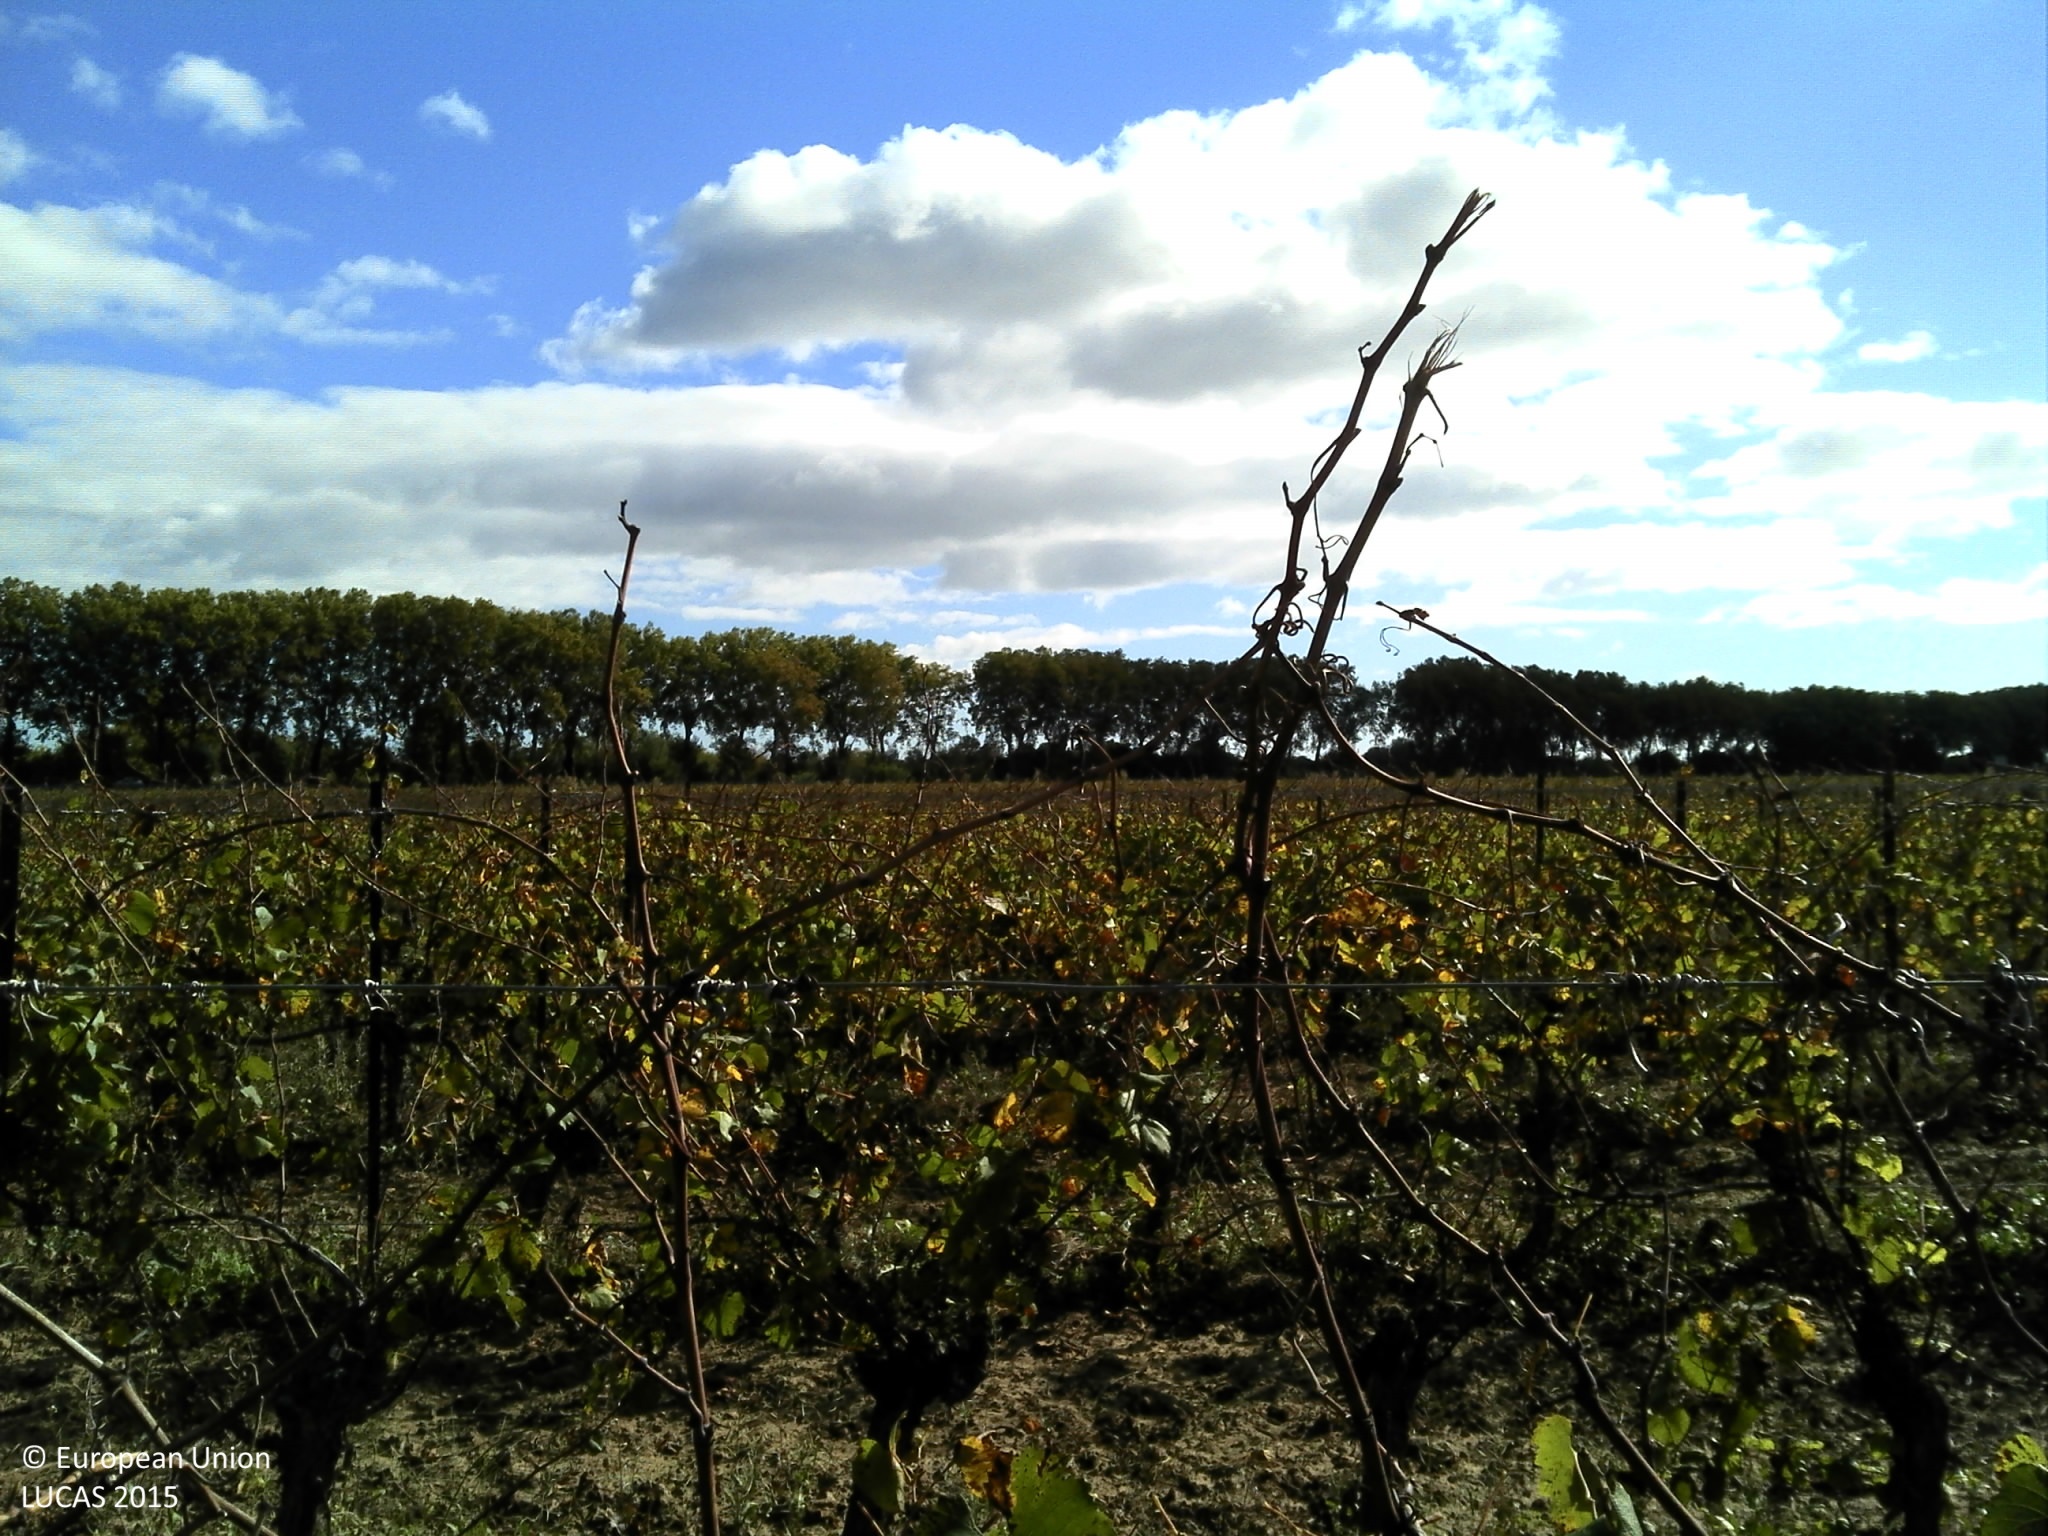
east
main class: Cropland
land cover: Vineyards
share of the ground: 10 - 25 %
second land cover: Other bare soil
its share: > 75 %
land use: Agriculture (excluding fallow land and kitchen gardens)
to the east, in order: Vineyards; Other bare soil; Tracks; Vineyards
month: October
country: FR
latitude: 43.3463
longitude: 3.4345
